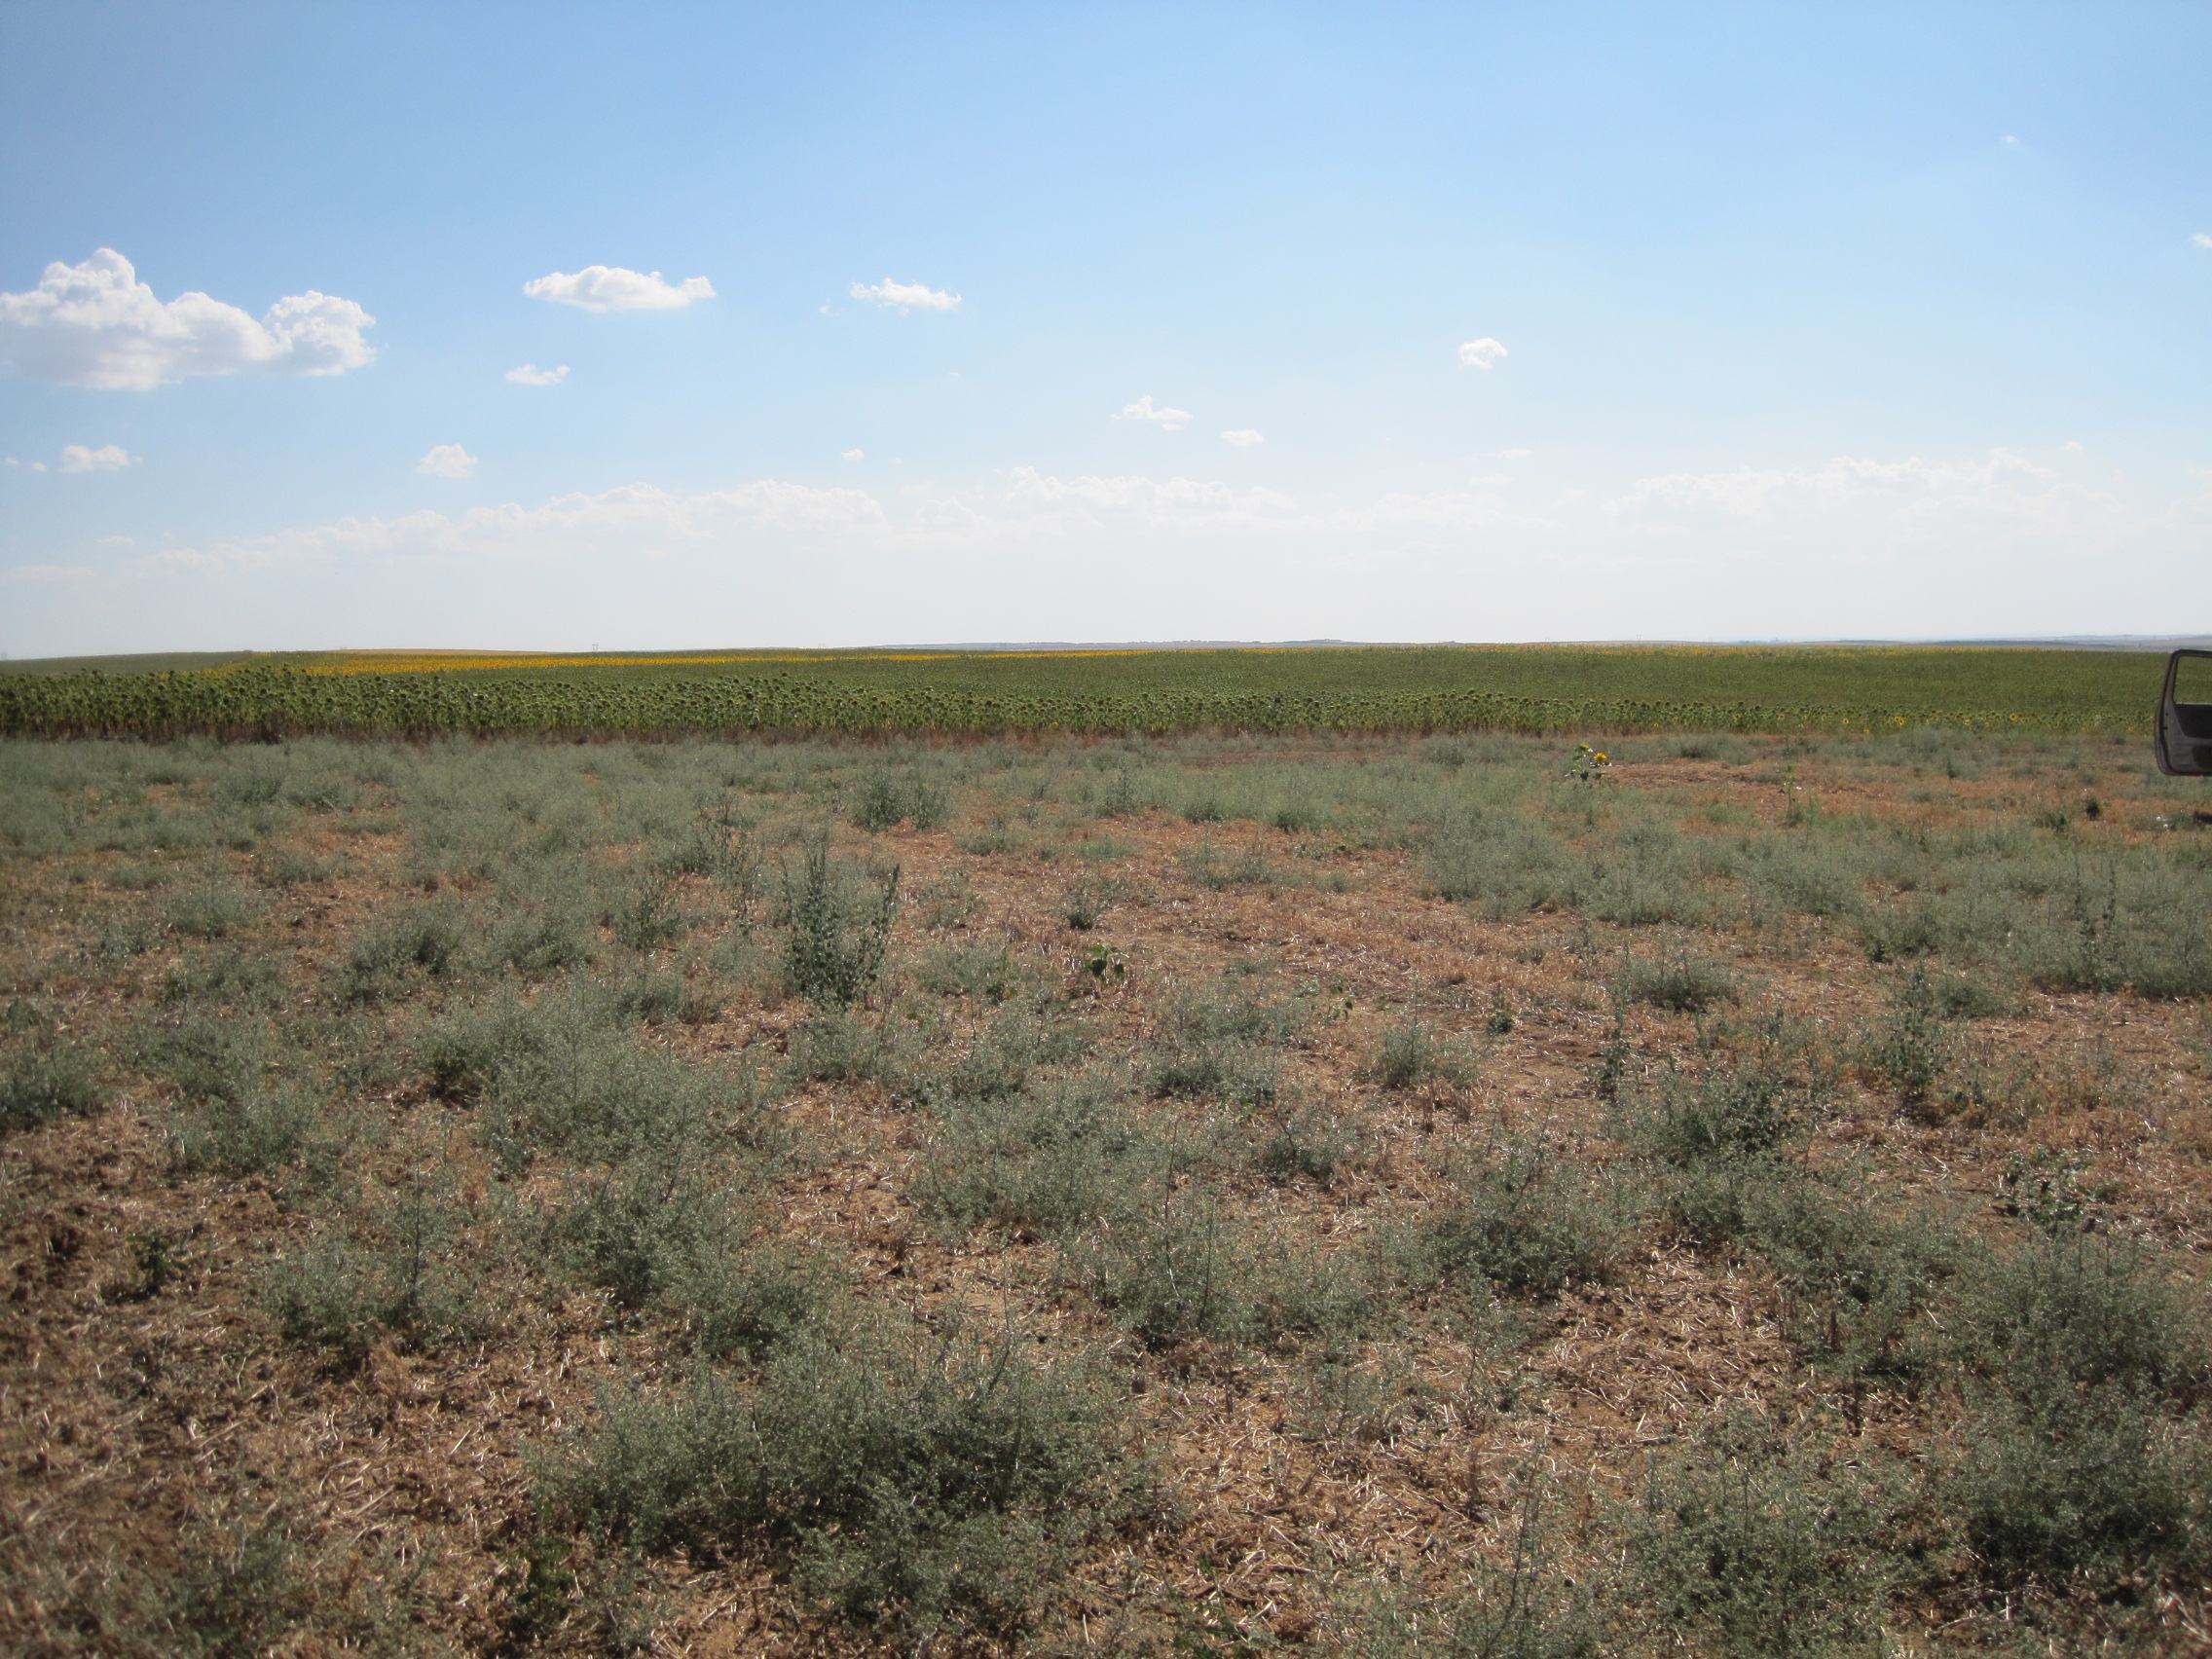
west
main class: Cropland
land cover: Dry pulses
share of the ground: < 10 %
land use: Agriculture (excluding fallow land and kitchen gardens)
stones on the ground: < 10 %
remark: Harvested field
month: July
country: ES
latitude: 41.8800
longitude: -5.2283
